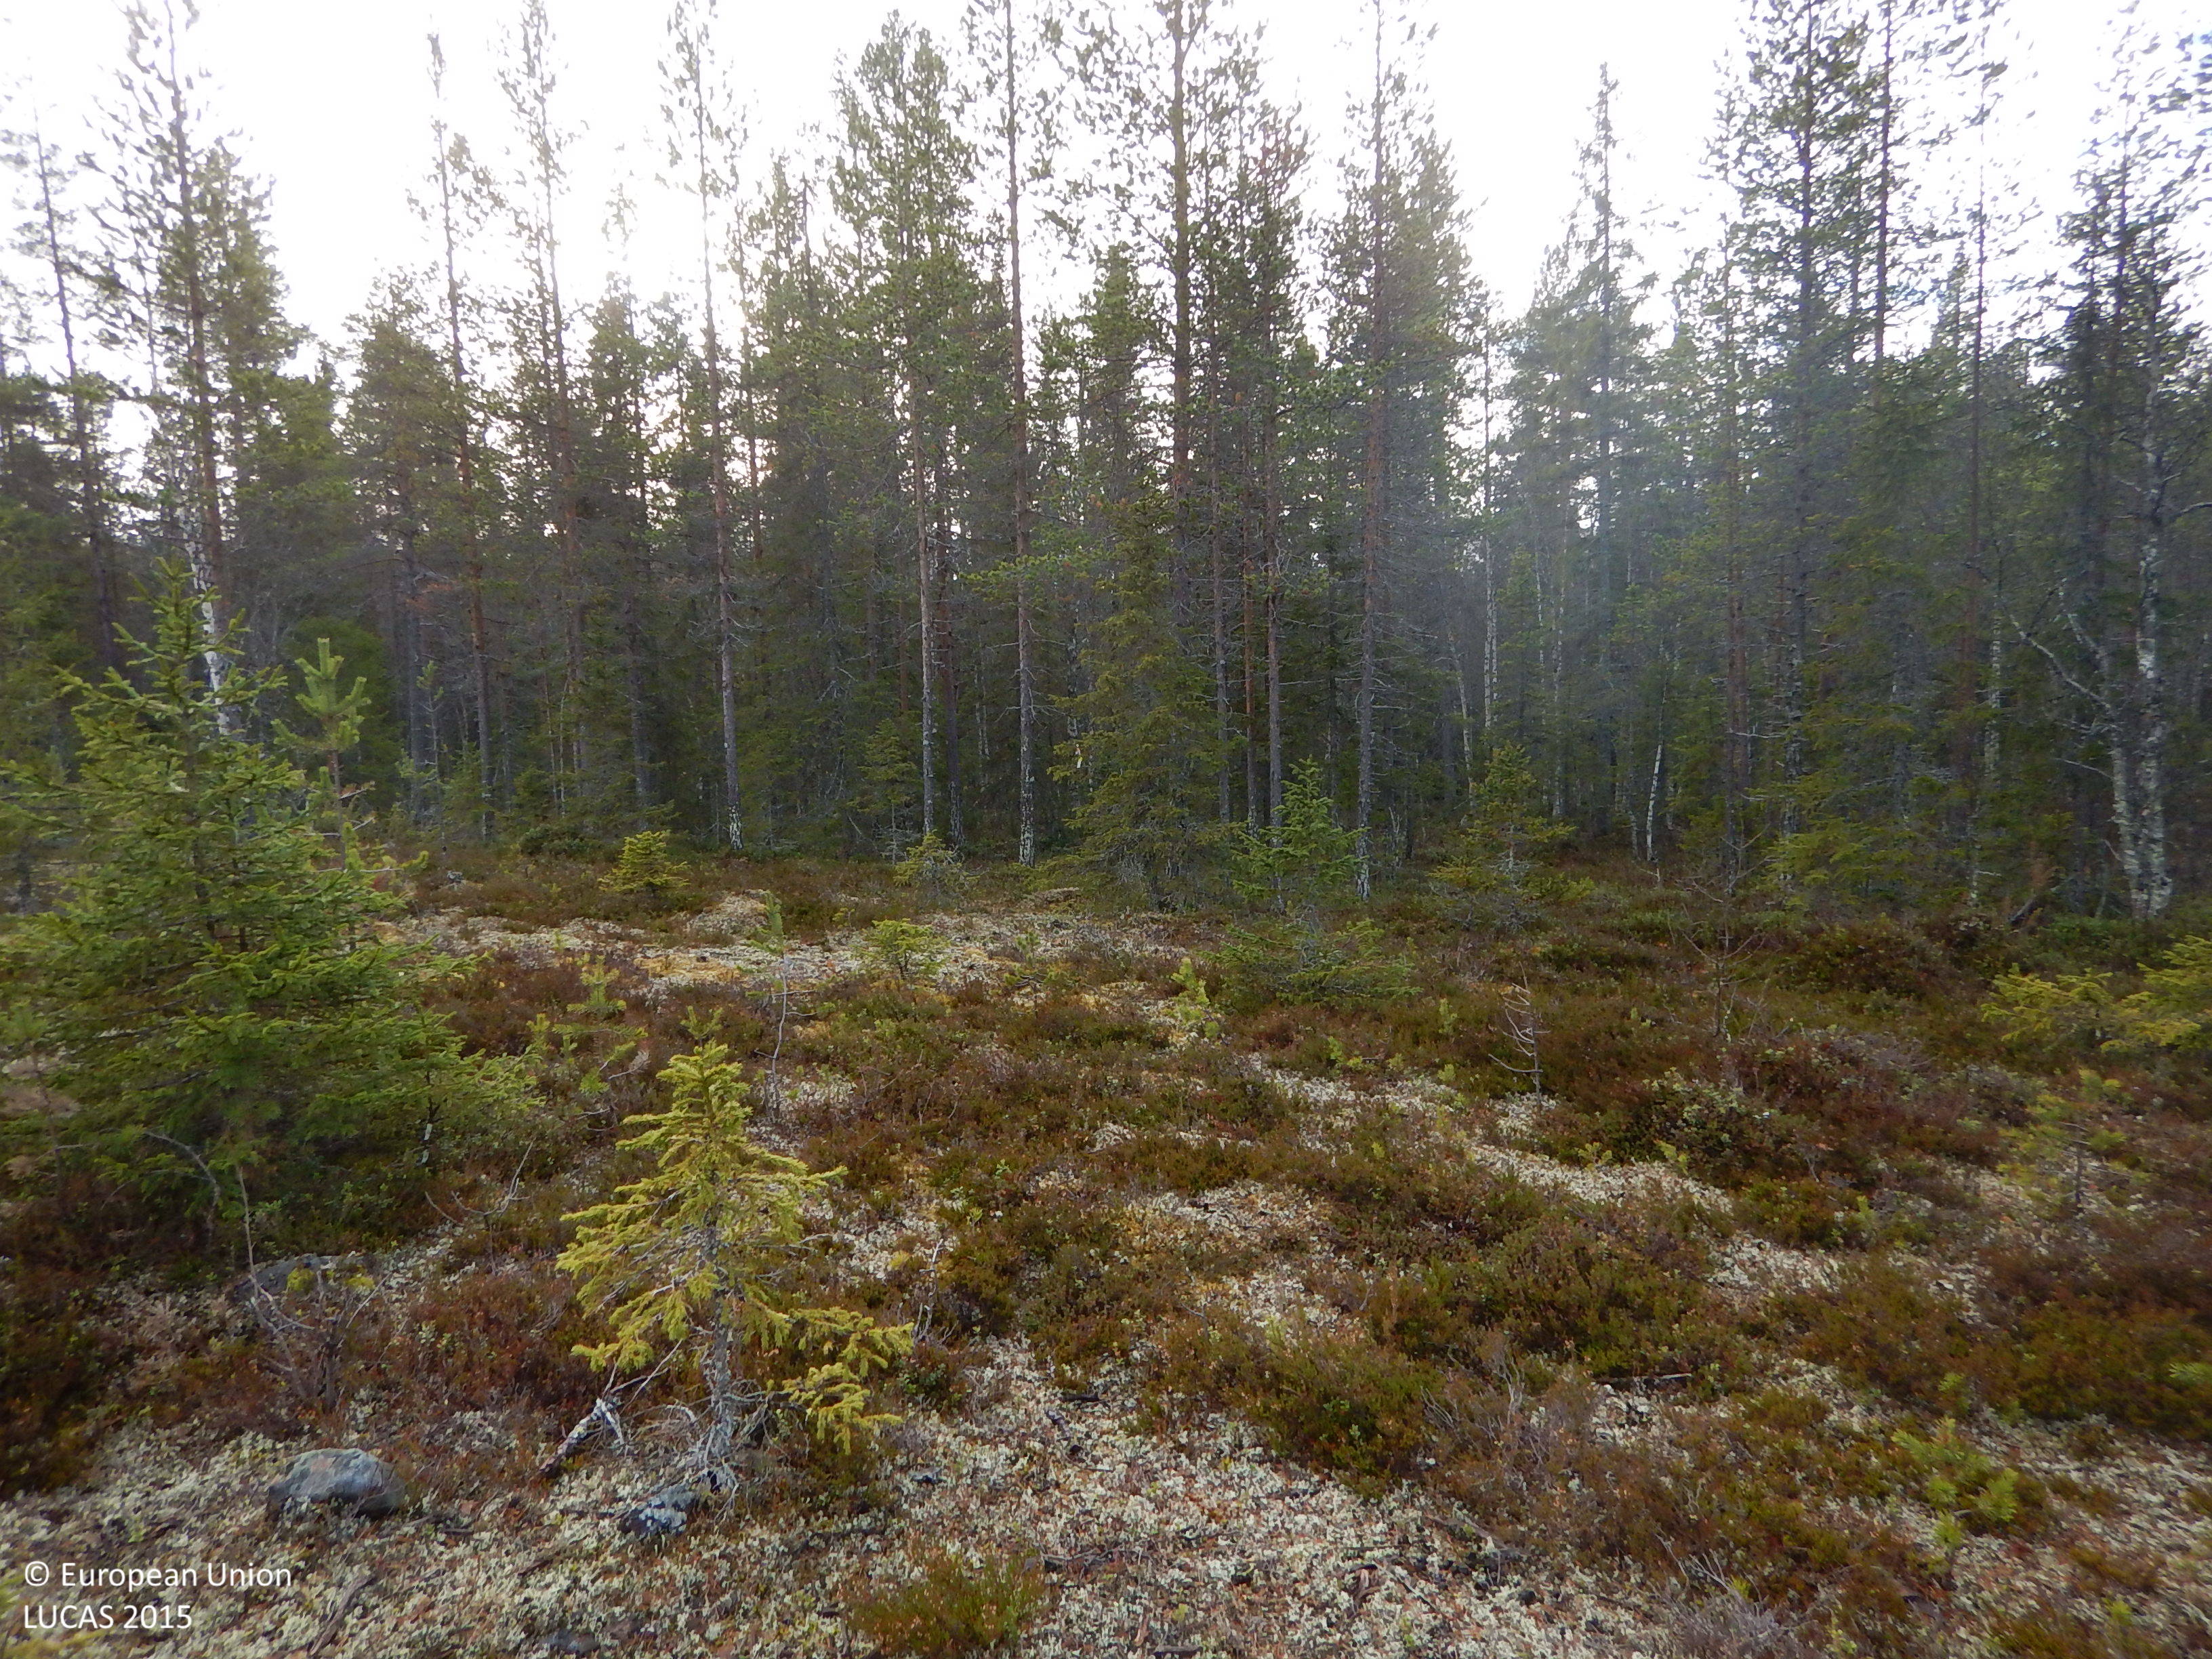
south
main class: Woodland
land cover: Pine dominated coniferous woodland
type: boreal forest
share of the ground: 10 - 25 %
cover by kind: shrubs 50 %, coniferous forest trees 25 %, lichens and mosses 20 %, herbaceous plants 5 %
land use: Forestry
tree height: < 5 m
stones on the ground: < 10 %
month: October
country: SE
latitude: 65.2818
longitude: 20.0617
